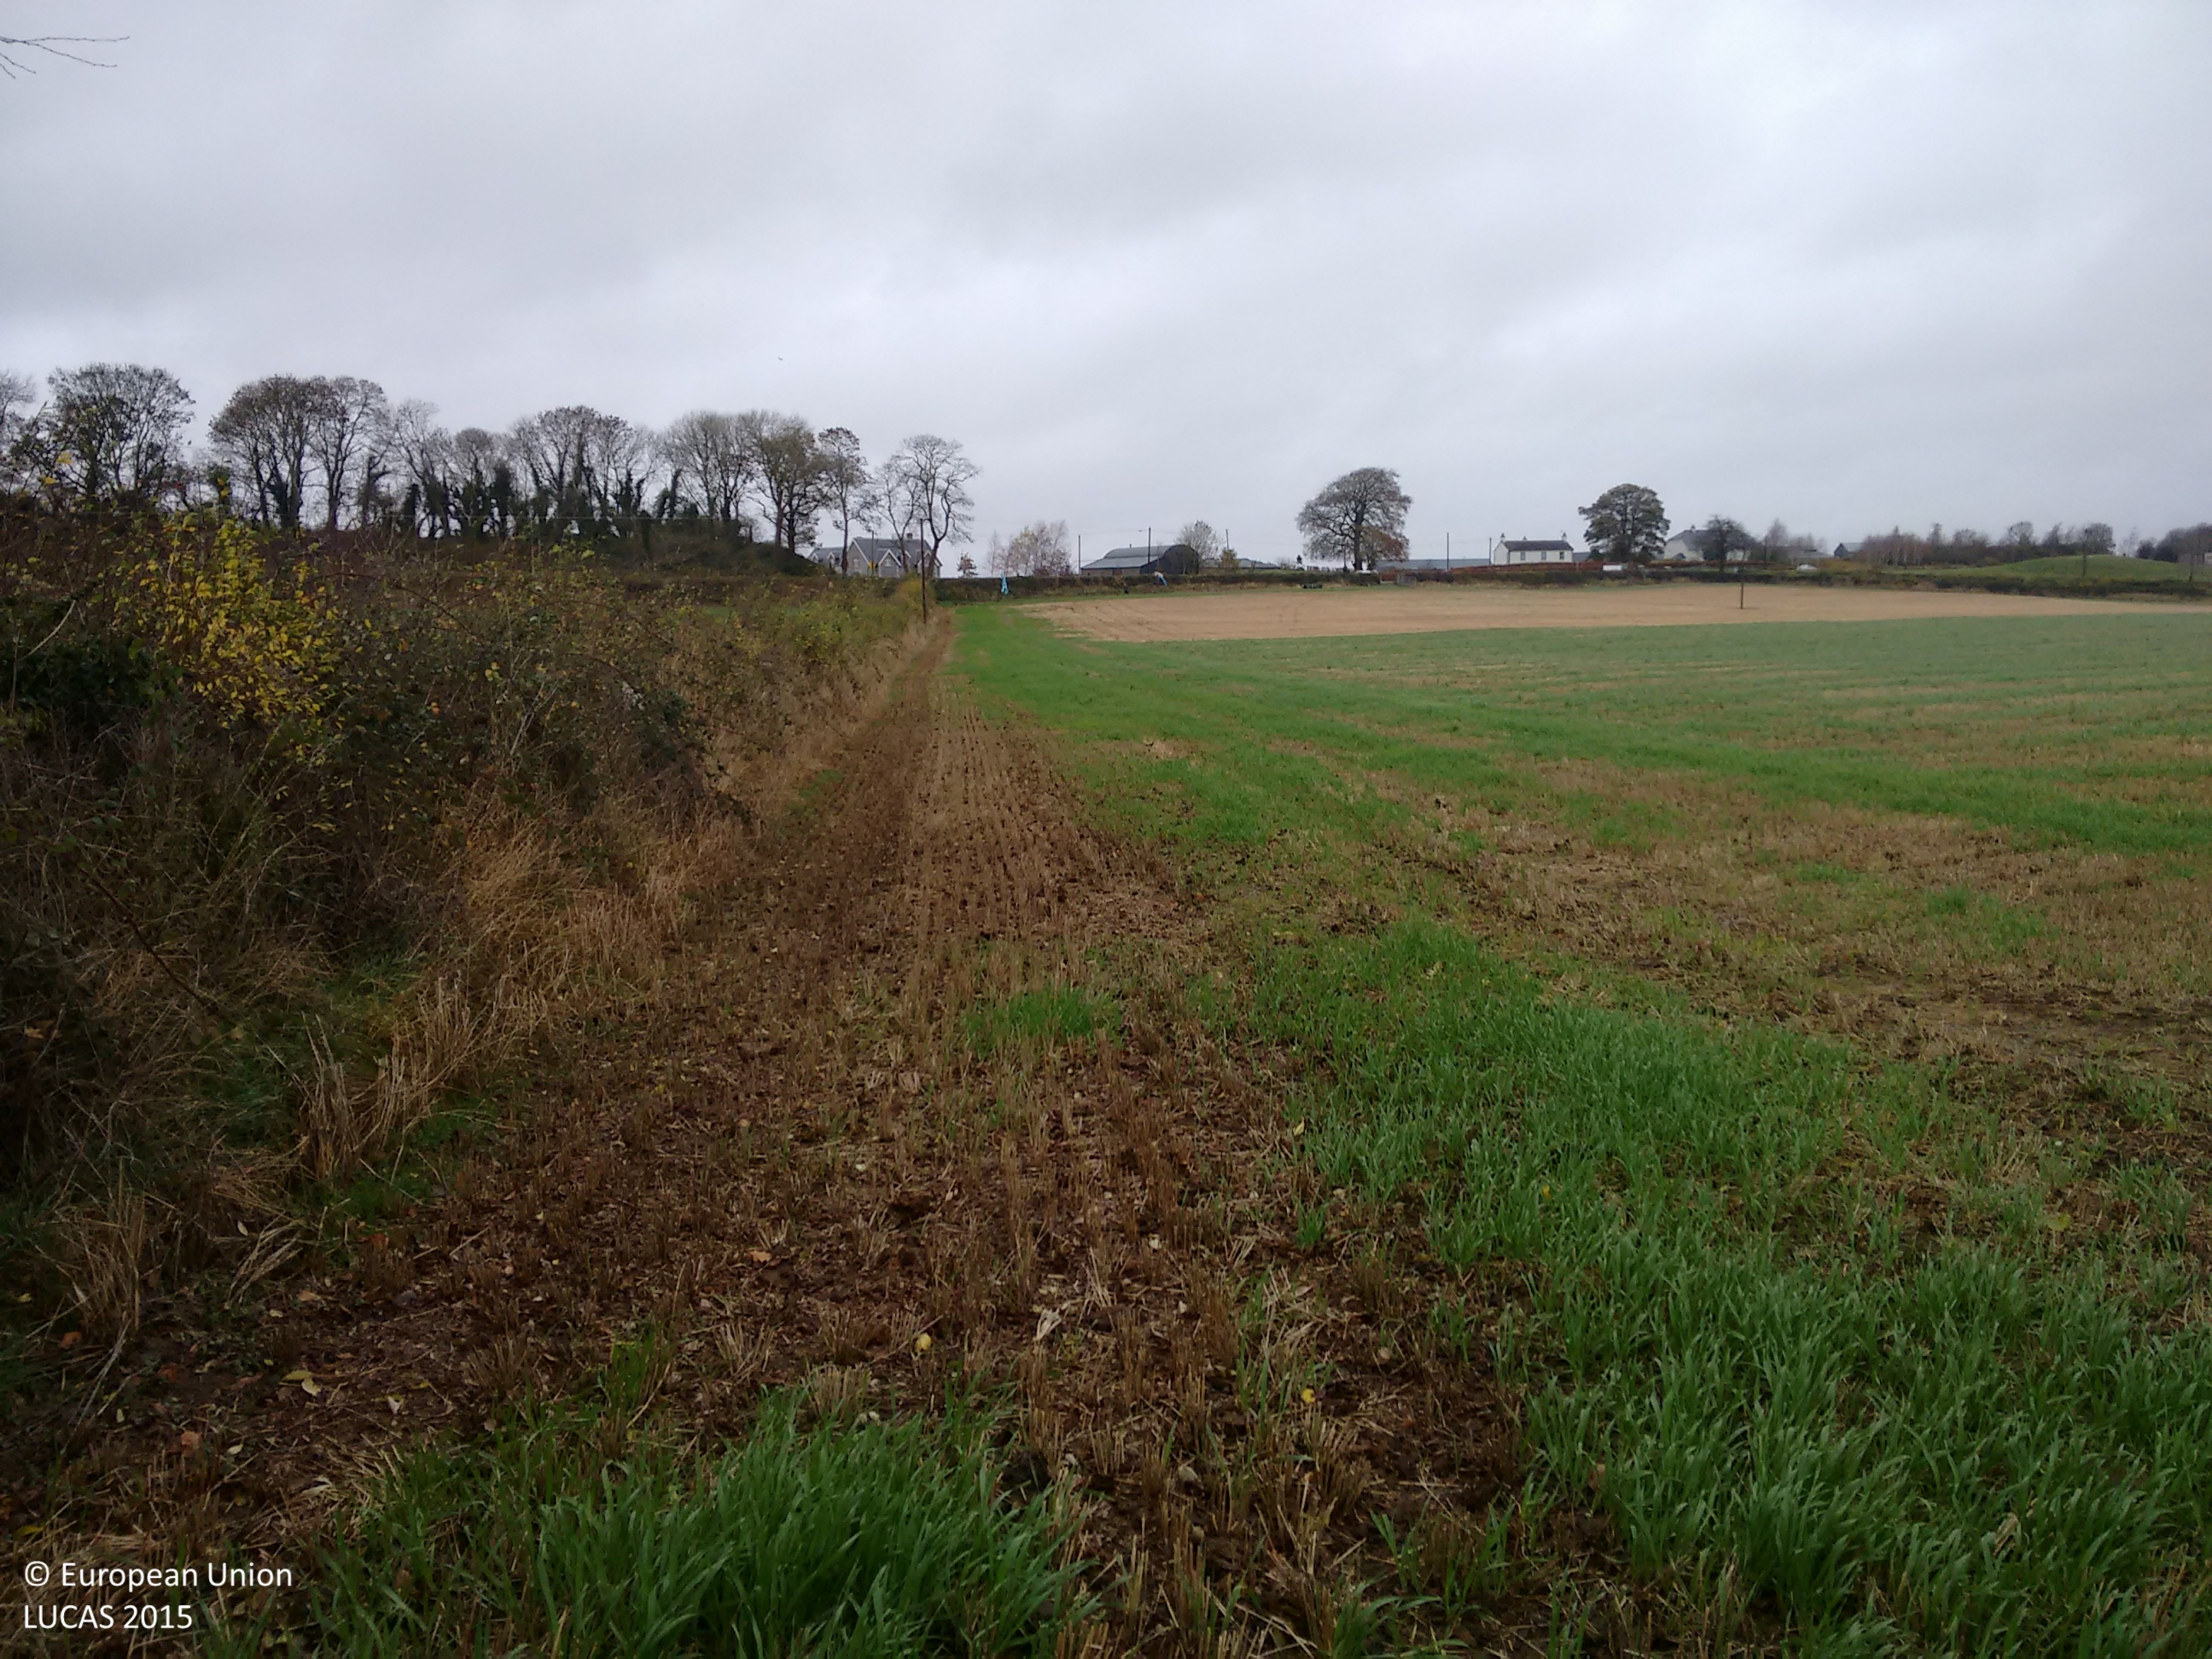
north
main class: Grassland
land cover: Grassland without tree/shrub cover
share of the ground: > 75 %
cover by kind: herbaceous plants 85 %, shrubs 5 %
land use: Agriculture (excluding fallow land and kitchen gardens)
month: November
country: IE
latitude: 53.1901
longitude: -7.6905
